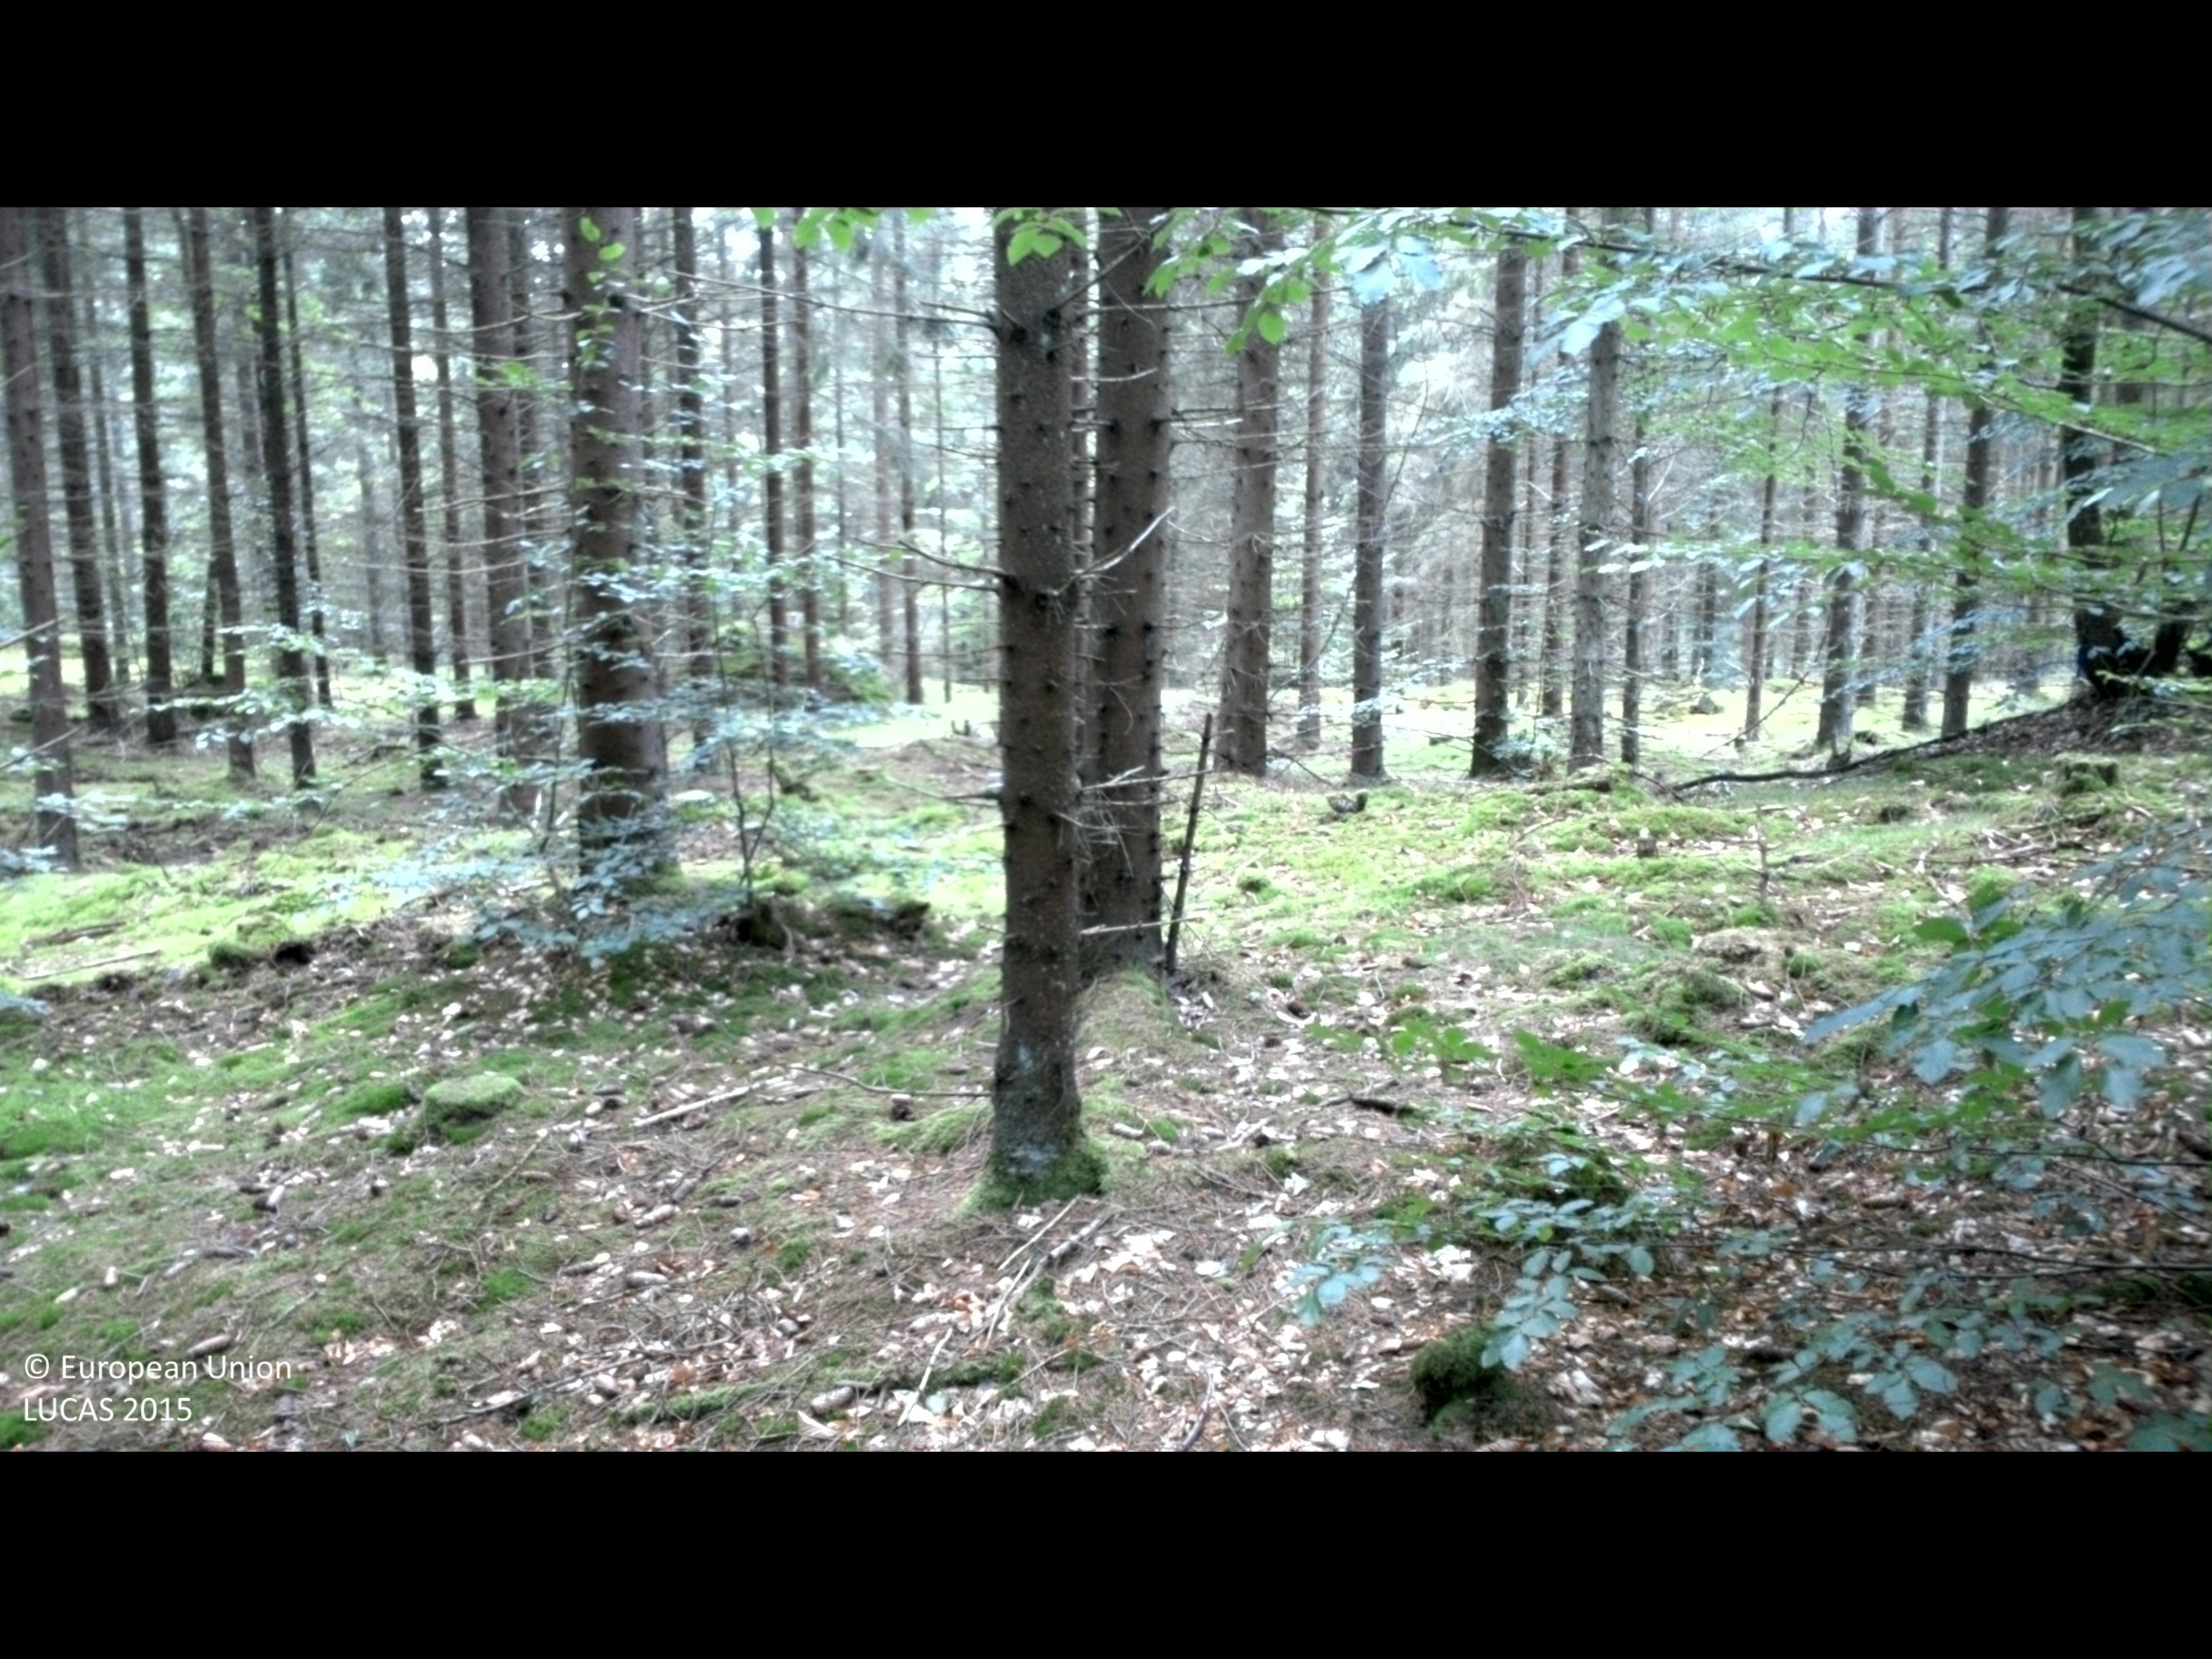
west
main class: Woodland
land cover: Spruce dominated coniferous woodland
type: boreal forest
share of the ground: 50 - 75 %
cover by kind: coniferous forest trees 65 %, lichens and mosses 25 %, broadleaved forest trees 10 %
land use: Forestry
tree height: > 5 m
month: August
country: SE
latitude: 56.2953
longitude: 15.2827
